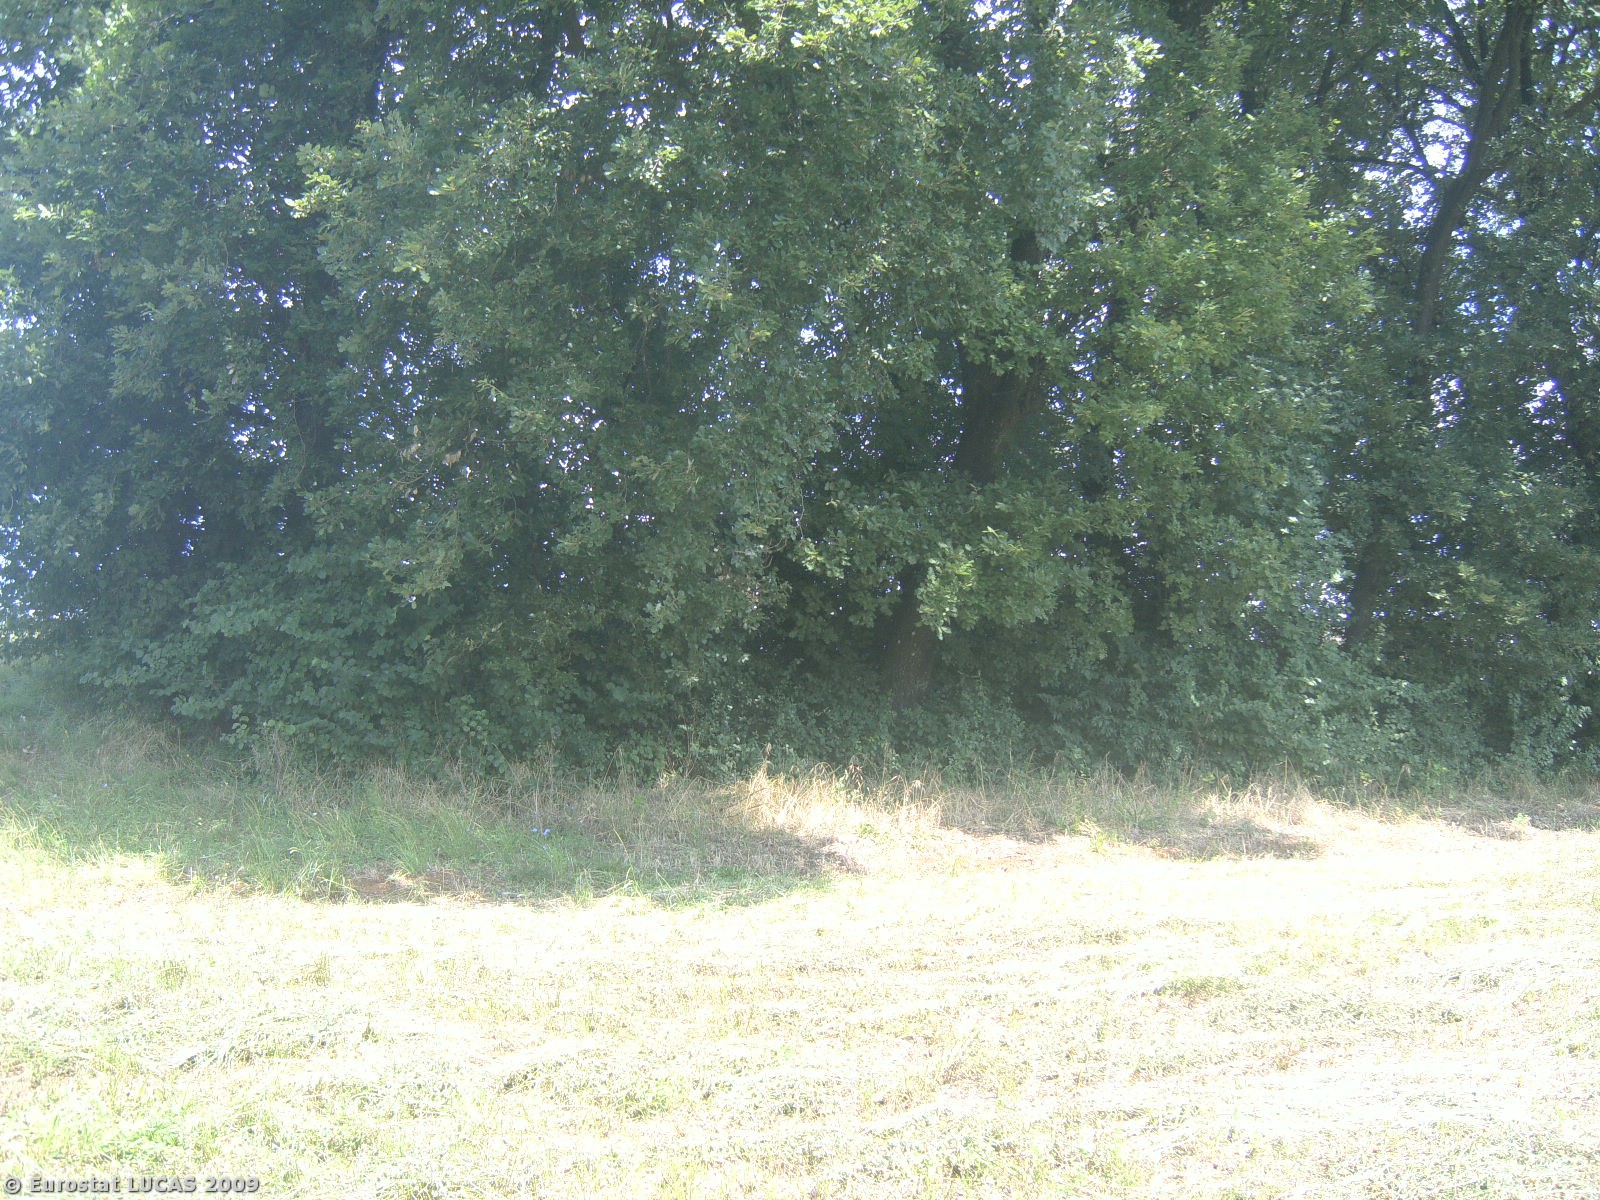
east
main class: Cropland
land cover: Other leguminous and mixtures for fodder
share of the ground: > 75 %
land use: Agriculture (excluding fallow land and kitchen gardens)
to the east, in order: Other leguminous and mixtures for fodder; Broadleaved woodland; Other leguminous and mixtures for fodder; Grass margins; Vineyards; Grassland with sparse tree/shrub cover; Electric lines; Grassland with sparse tree/shrub cover; Grassland without tree/shrub cover; Olive groves; Grassland with sparse tree/shrub cover; Grassland without tree/shrub cover; Paved roads, cycling and walking lanes; Fences; Artificial constructions in urban areas; Grassland with sparse tree/shrub cover
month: July
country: IT
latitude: 41.6760
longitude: 13.3628
